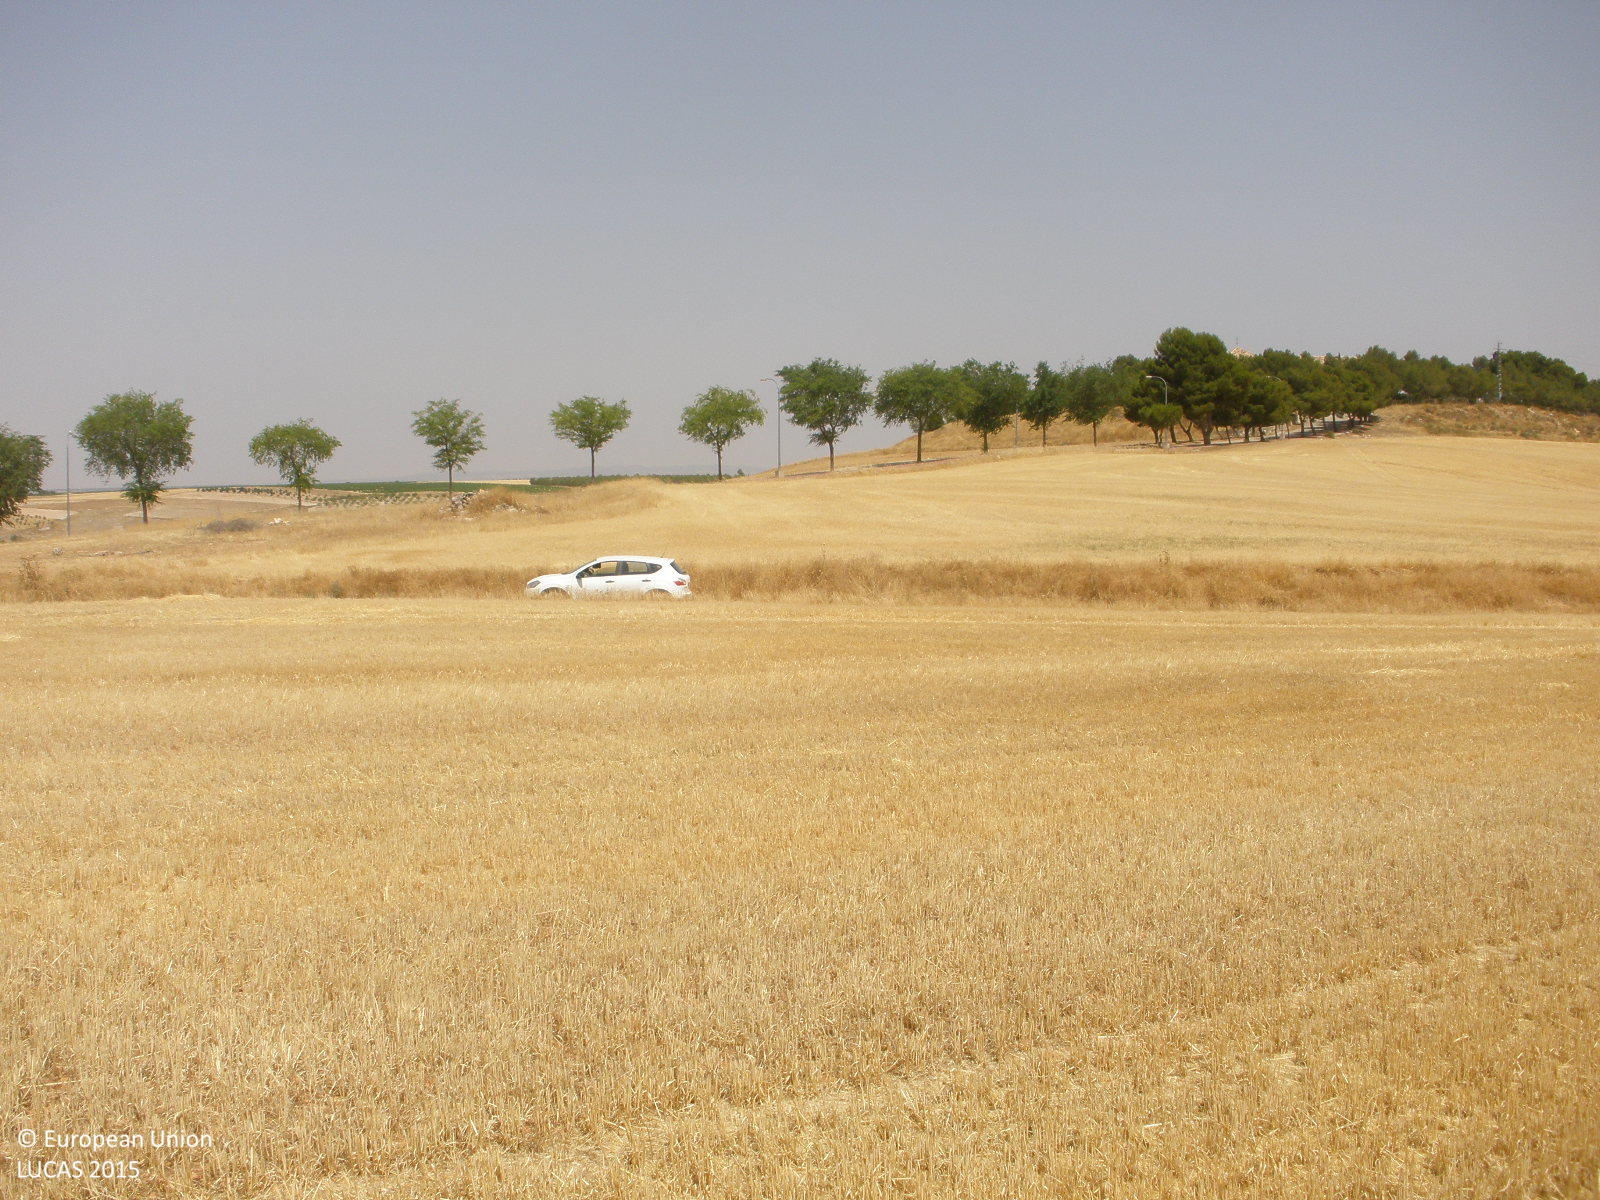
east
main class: Cropland
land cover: Common wheat
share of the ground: < 10 %
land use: Agriculture (excluding fallow land and kitchen gardens)
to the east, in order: Common wheat; Grass margins; Tracks; Grass margins; Common wheat; Managed hedges; Paved roads, cycling and walking lanes; Spontaneously vegetated surfaces
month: July
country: ES
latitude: 39.7378
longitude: -3.1964
